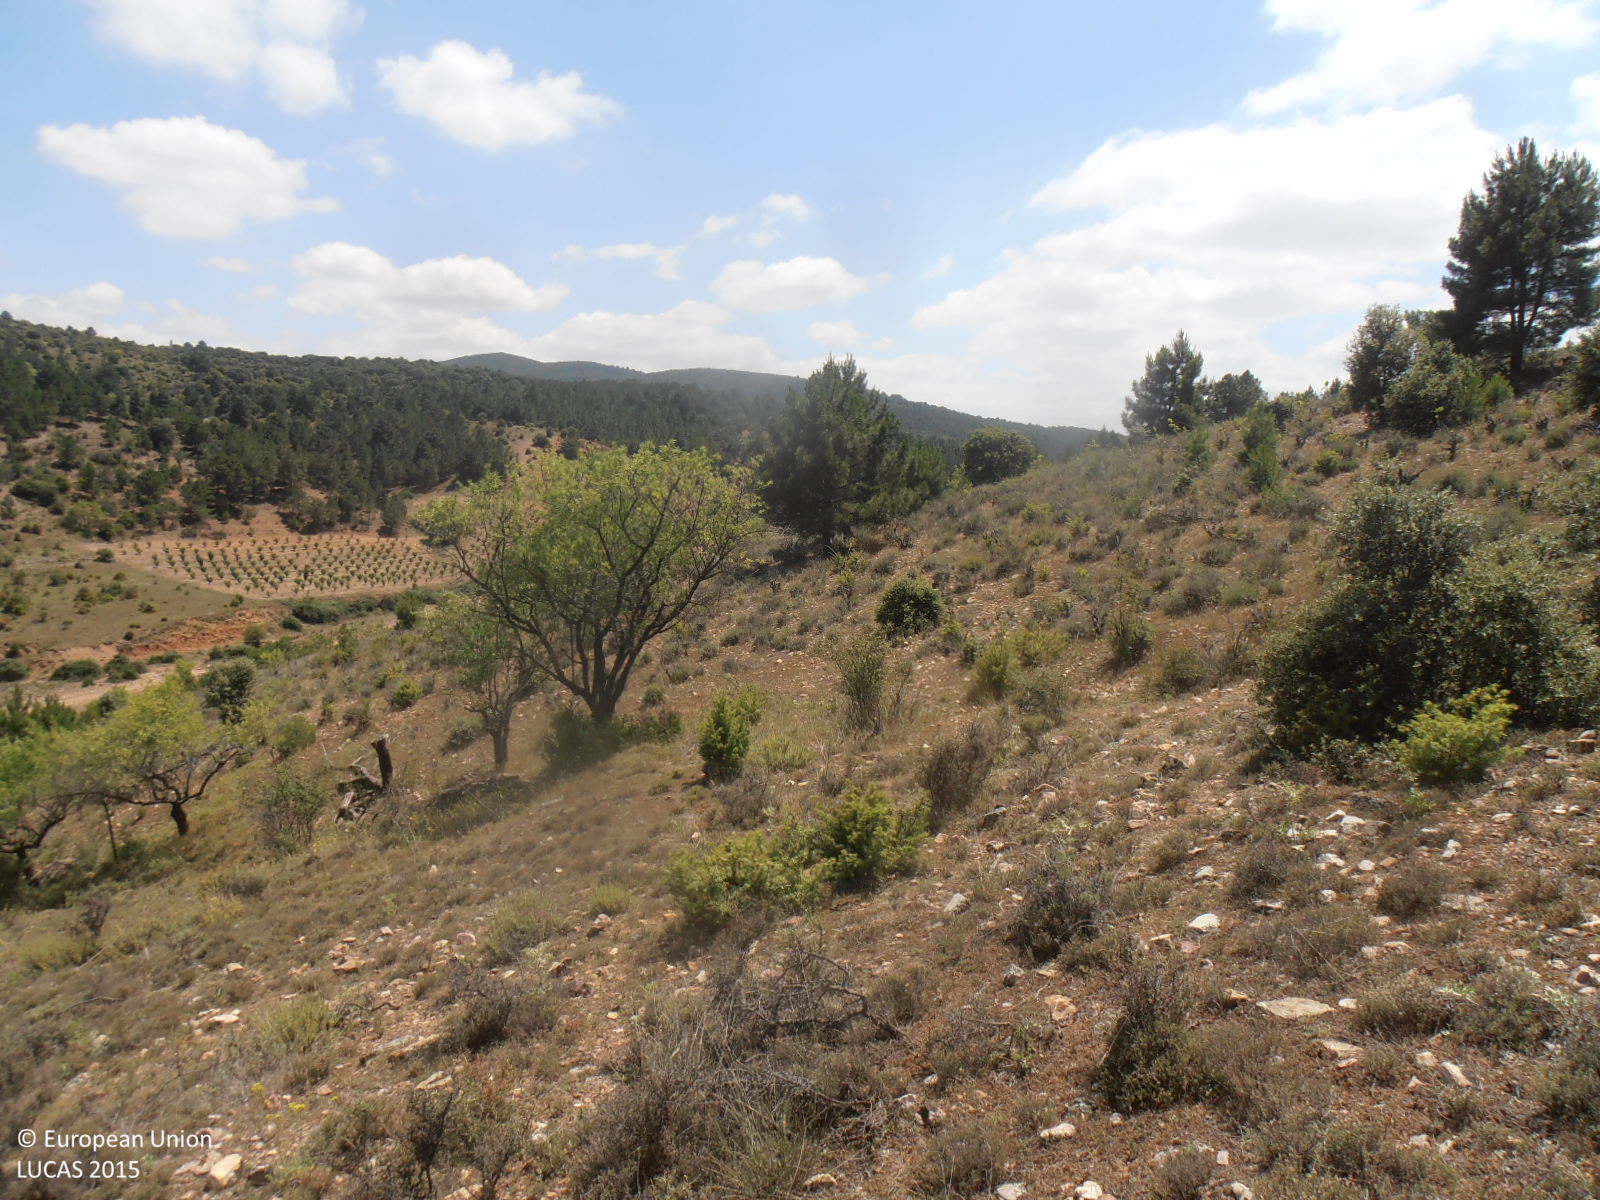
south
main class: Shrubland
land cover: Shrubland with sparse tree cover
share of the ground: 50 - 75 %
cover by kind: shrubs 60 %, consolidated bare surface 20 %, herbaceous plants 15 %, coniferous forest trees 5 %
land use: Semi-natural and natural areas not in use
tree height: < 5 m
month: June
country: ES
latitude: 41.2791
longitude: -1.4003
